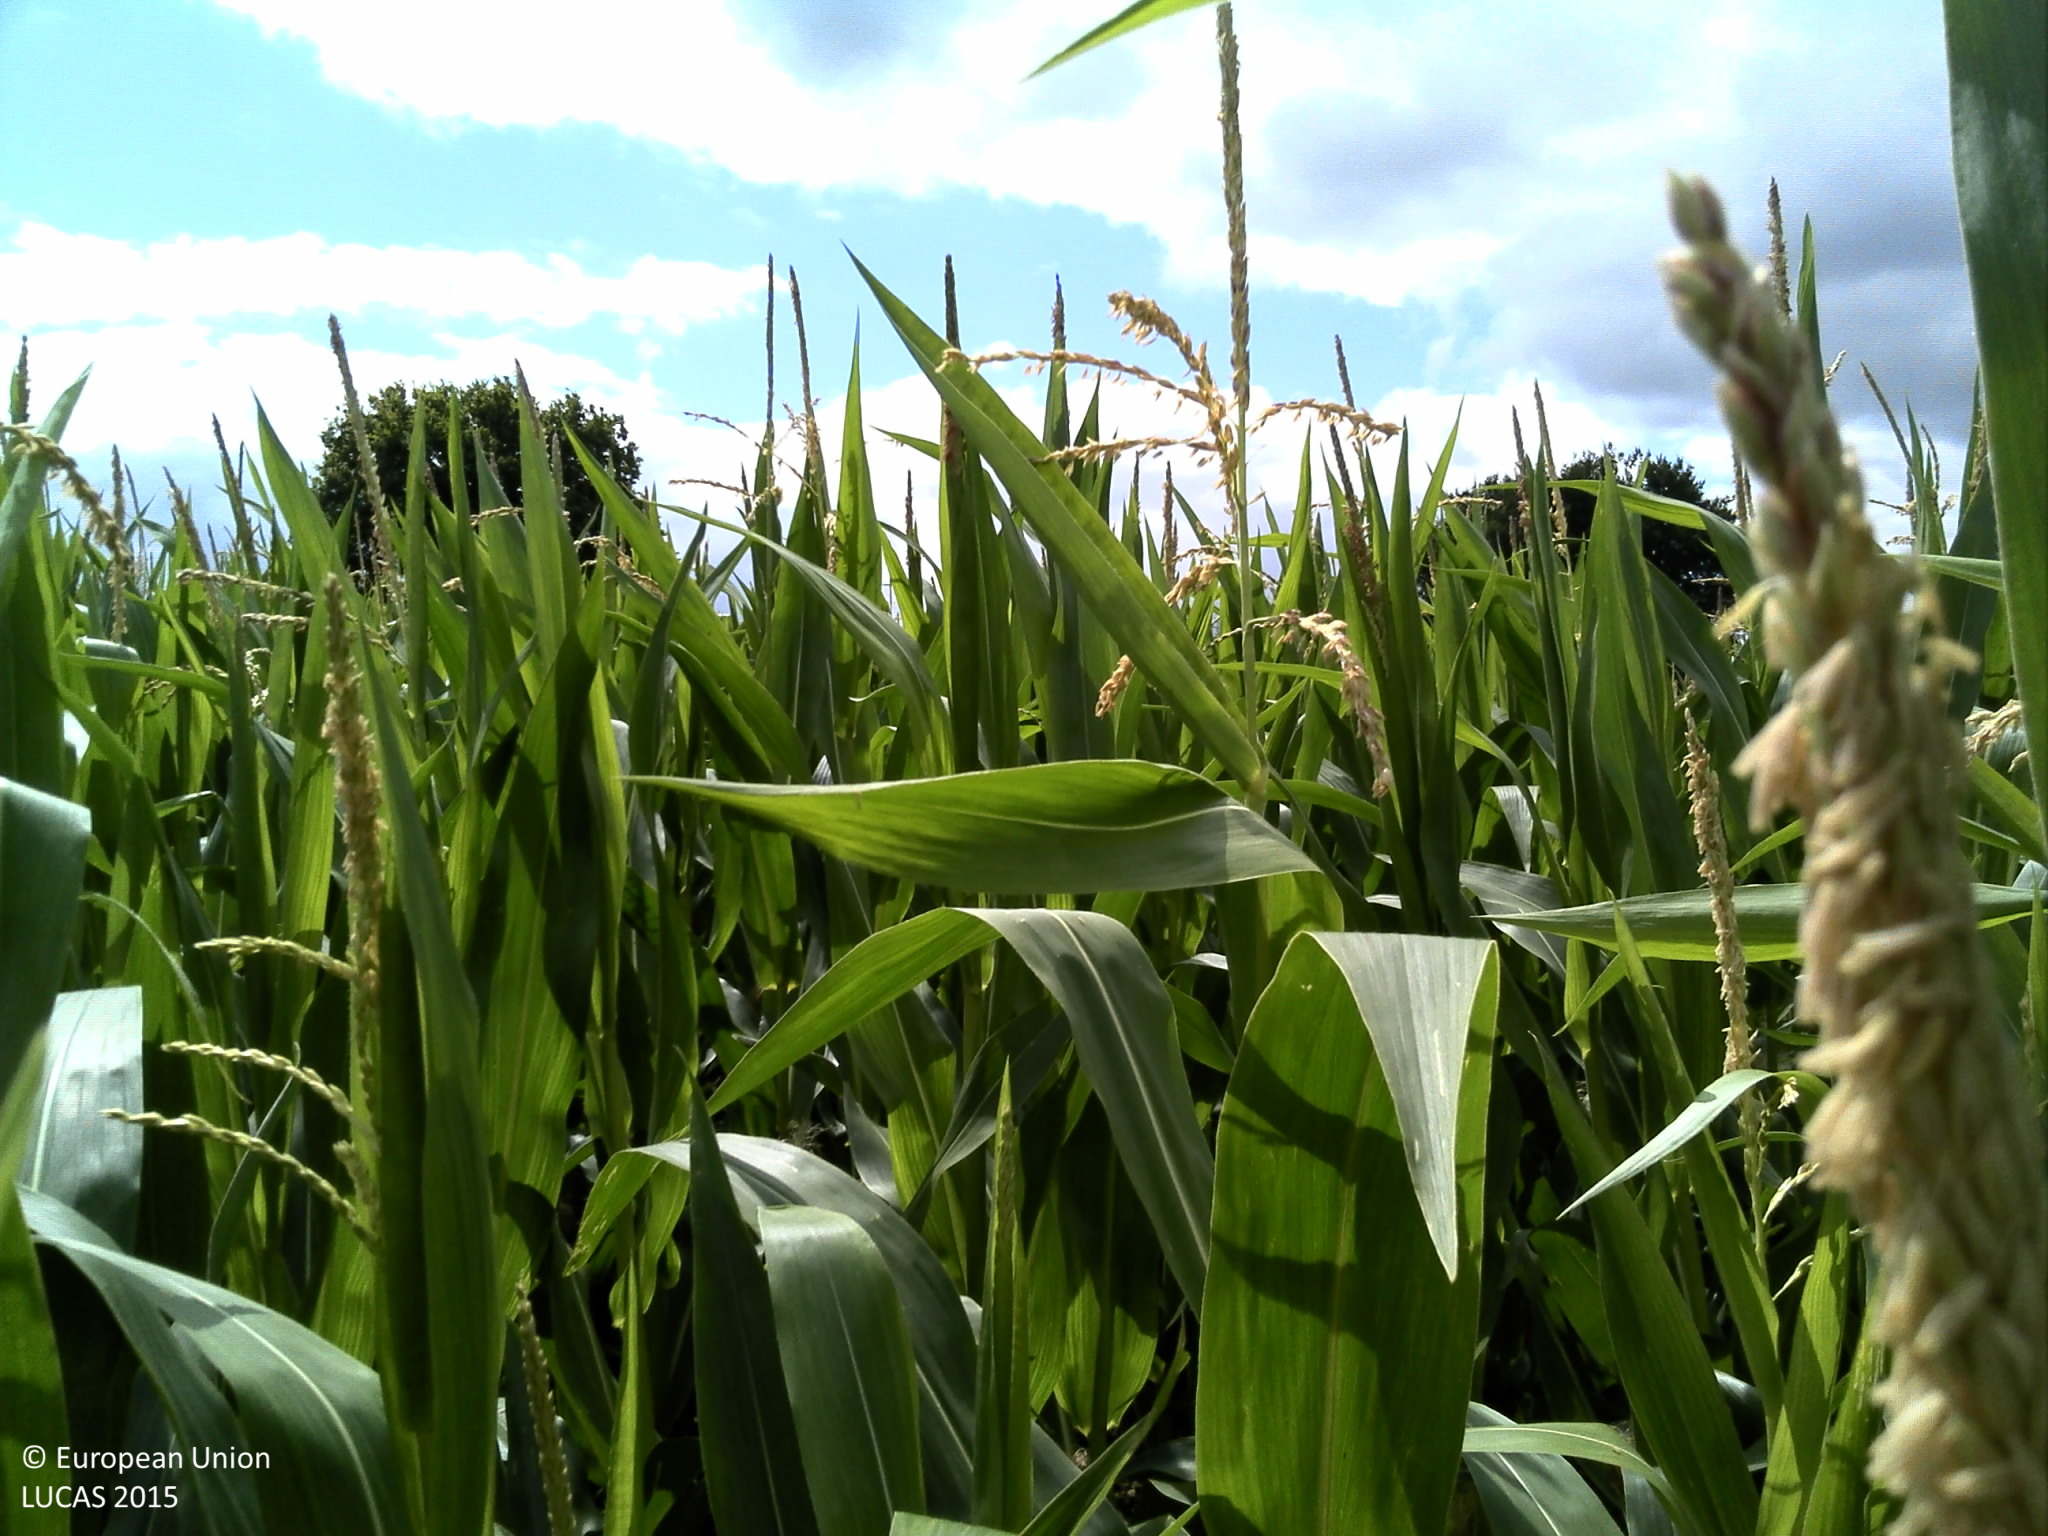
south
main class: Cropland
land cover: Maize
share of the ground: > 75 %
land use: Agriculture (excluding fallow land and kitchen gardens)
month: July
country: FR
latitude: 48.2927
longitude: -3.7092
